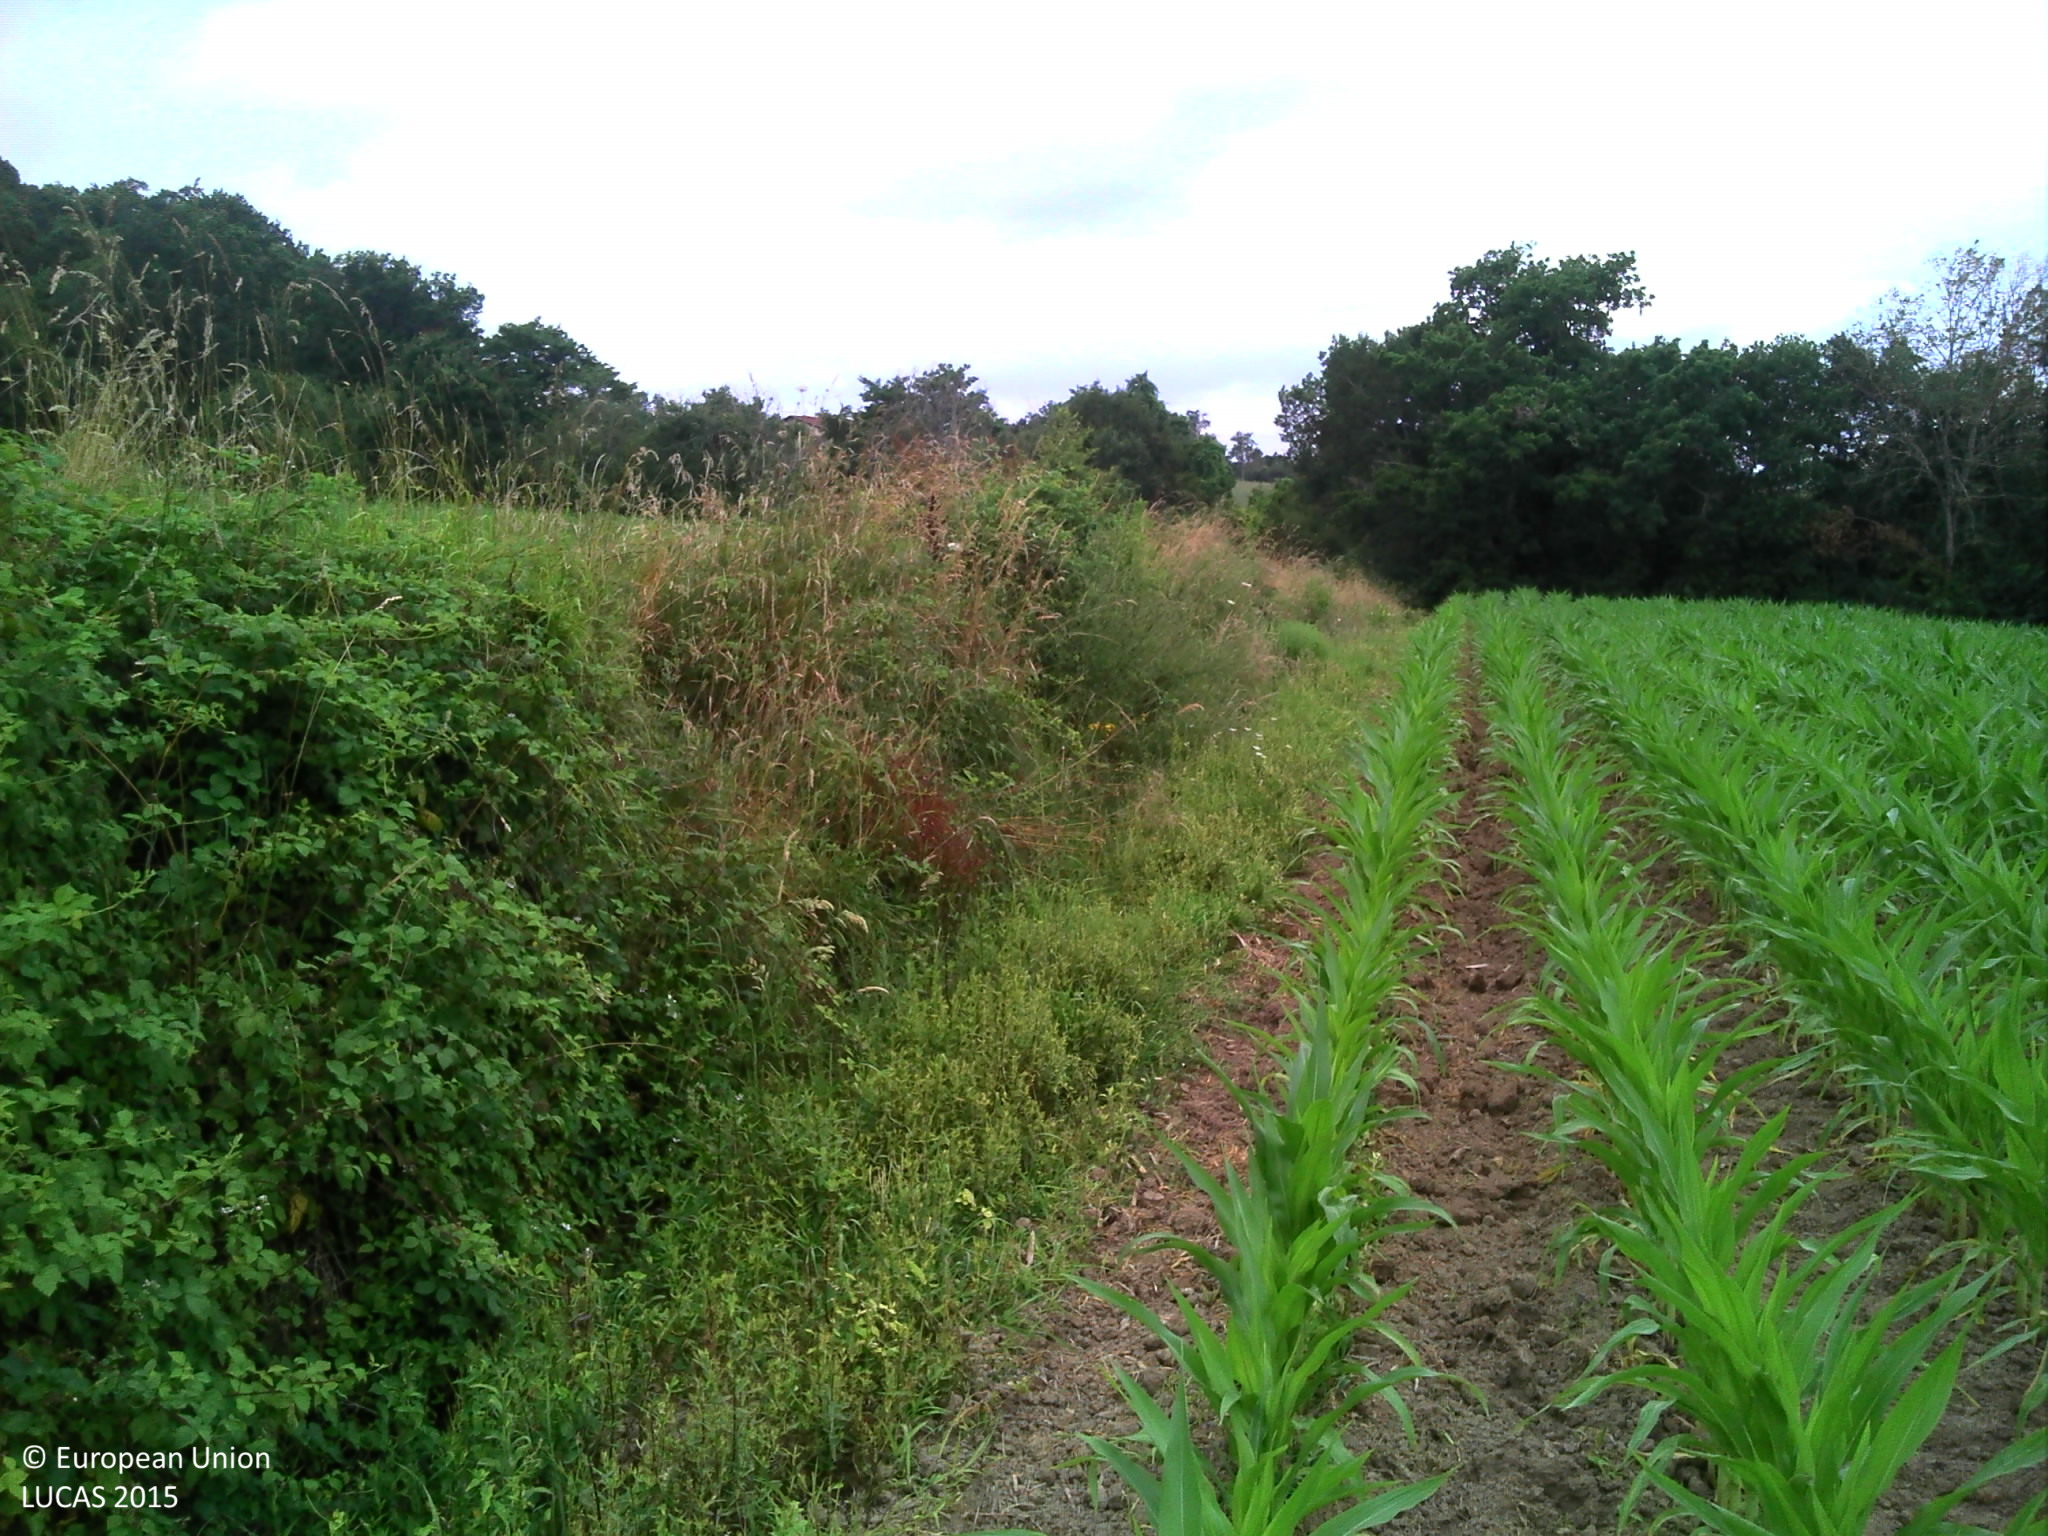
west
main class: Cropland
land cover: Maize
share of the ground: 50 - 75 %
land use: Agriculture (excluding fallow land and kitchen gardens)
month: July
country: FR
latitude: 43.6465
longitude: -0.7361
